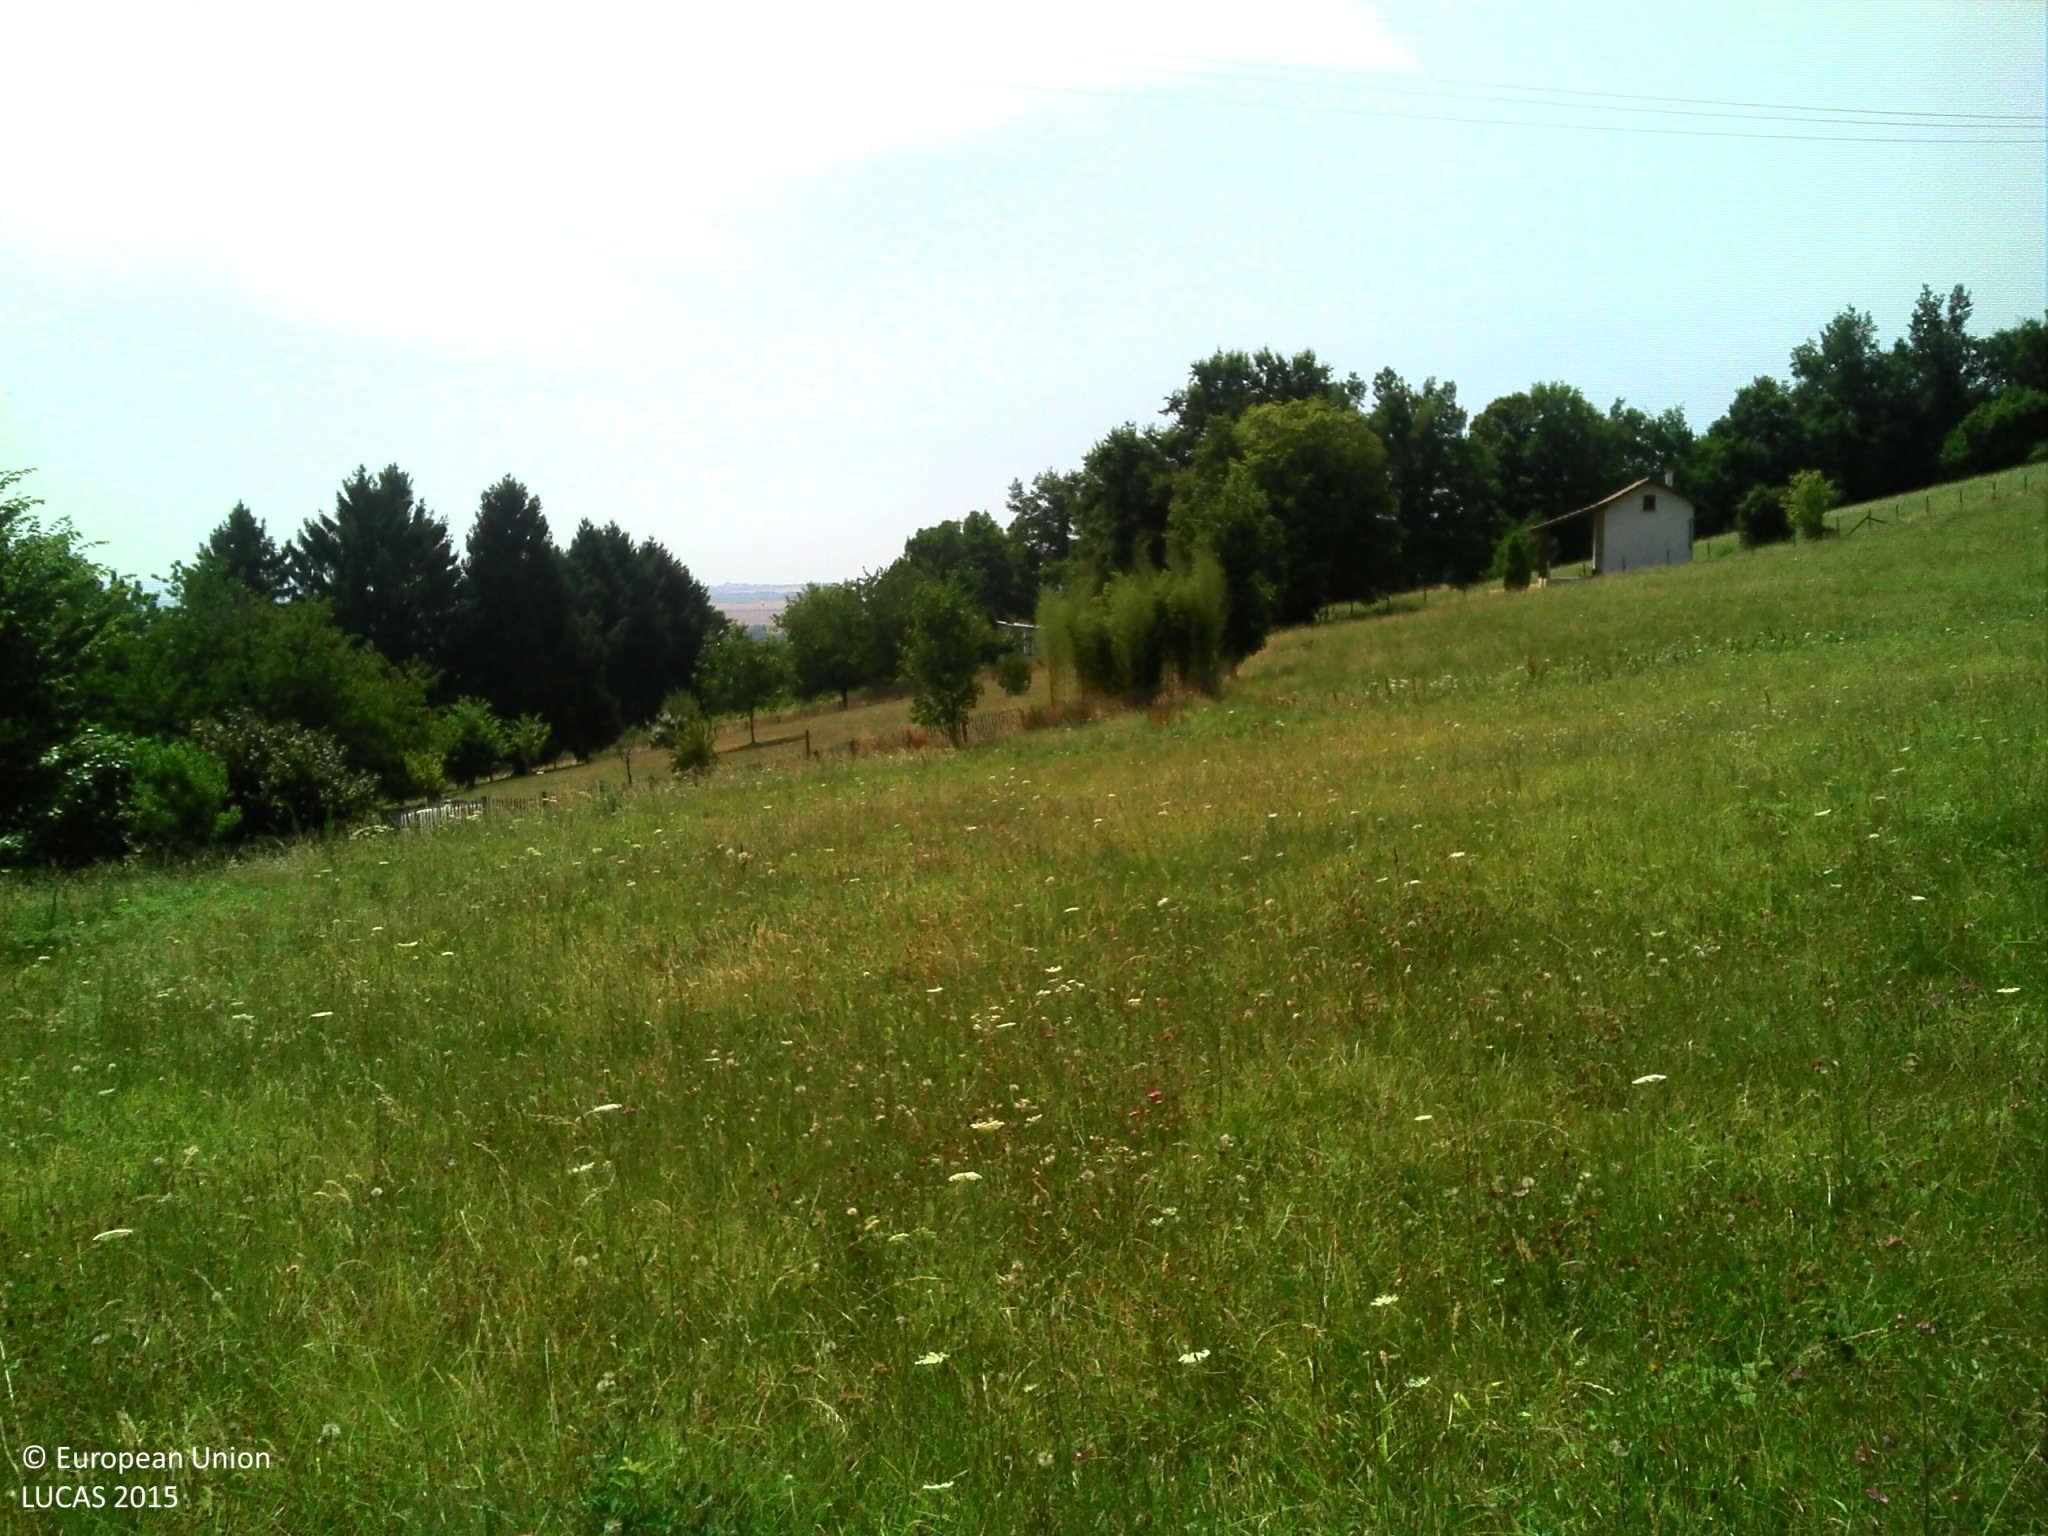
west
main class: Grassland
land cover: Grassland without tree/shrub cover
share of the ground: > 75 %
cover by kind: herbaceous plants 100 %
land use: Agriculture (excluding fallow land and kitchen gardens)
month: July
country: FR
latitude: 45.3982
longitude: 5.2654
